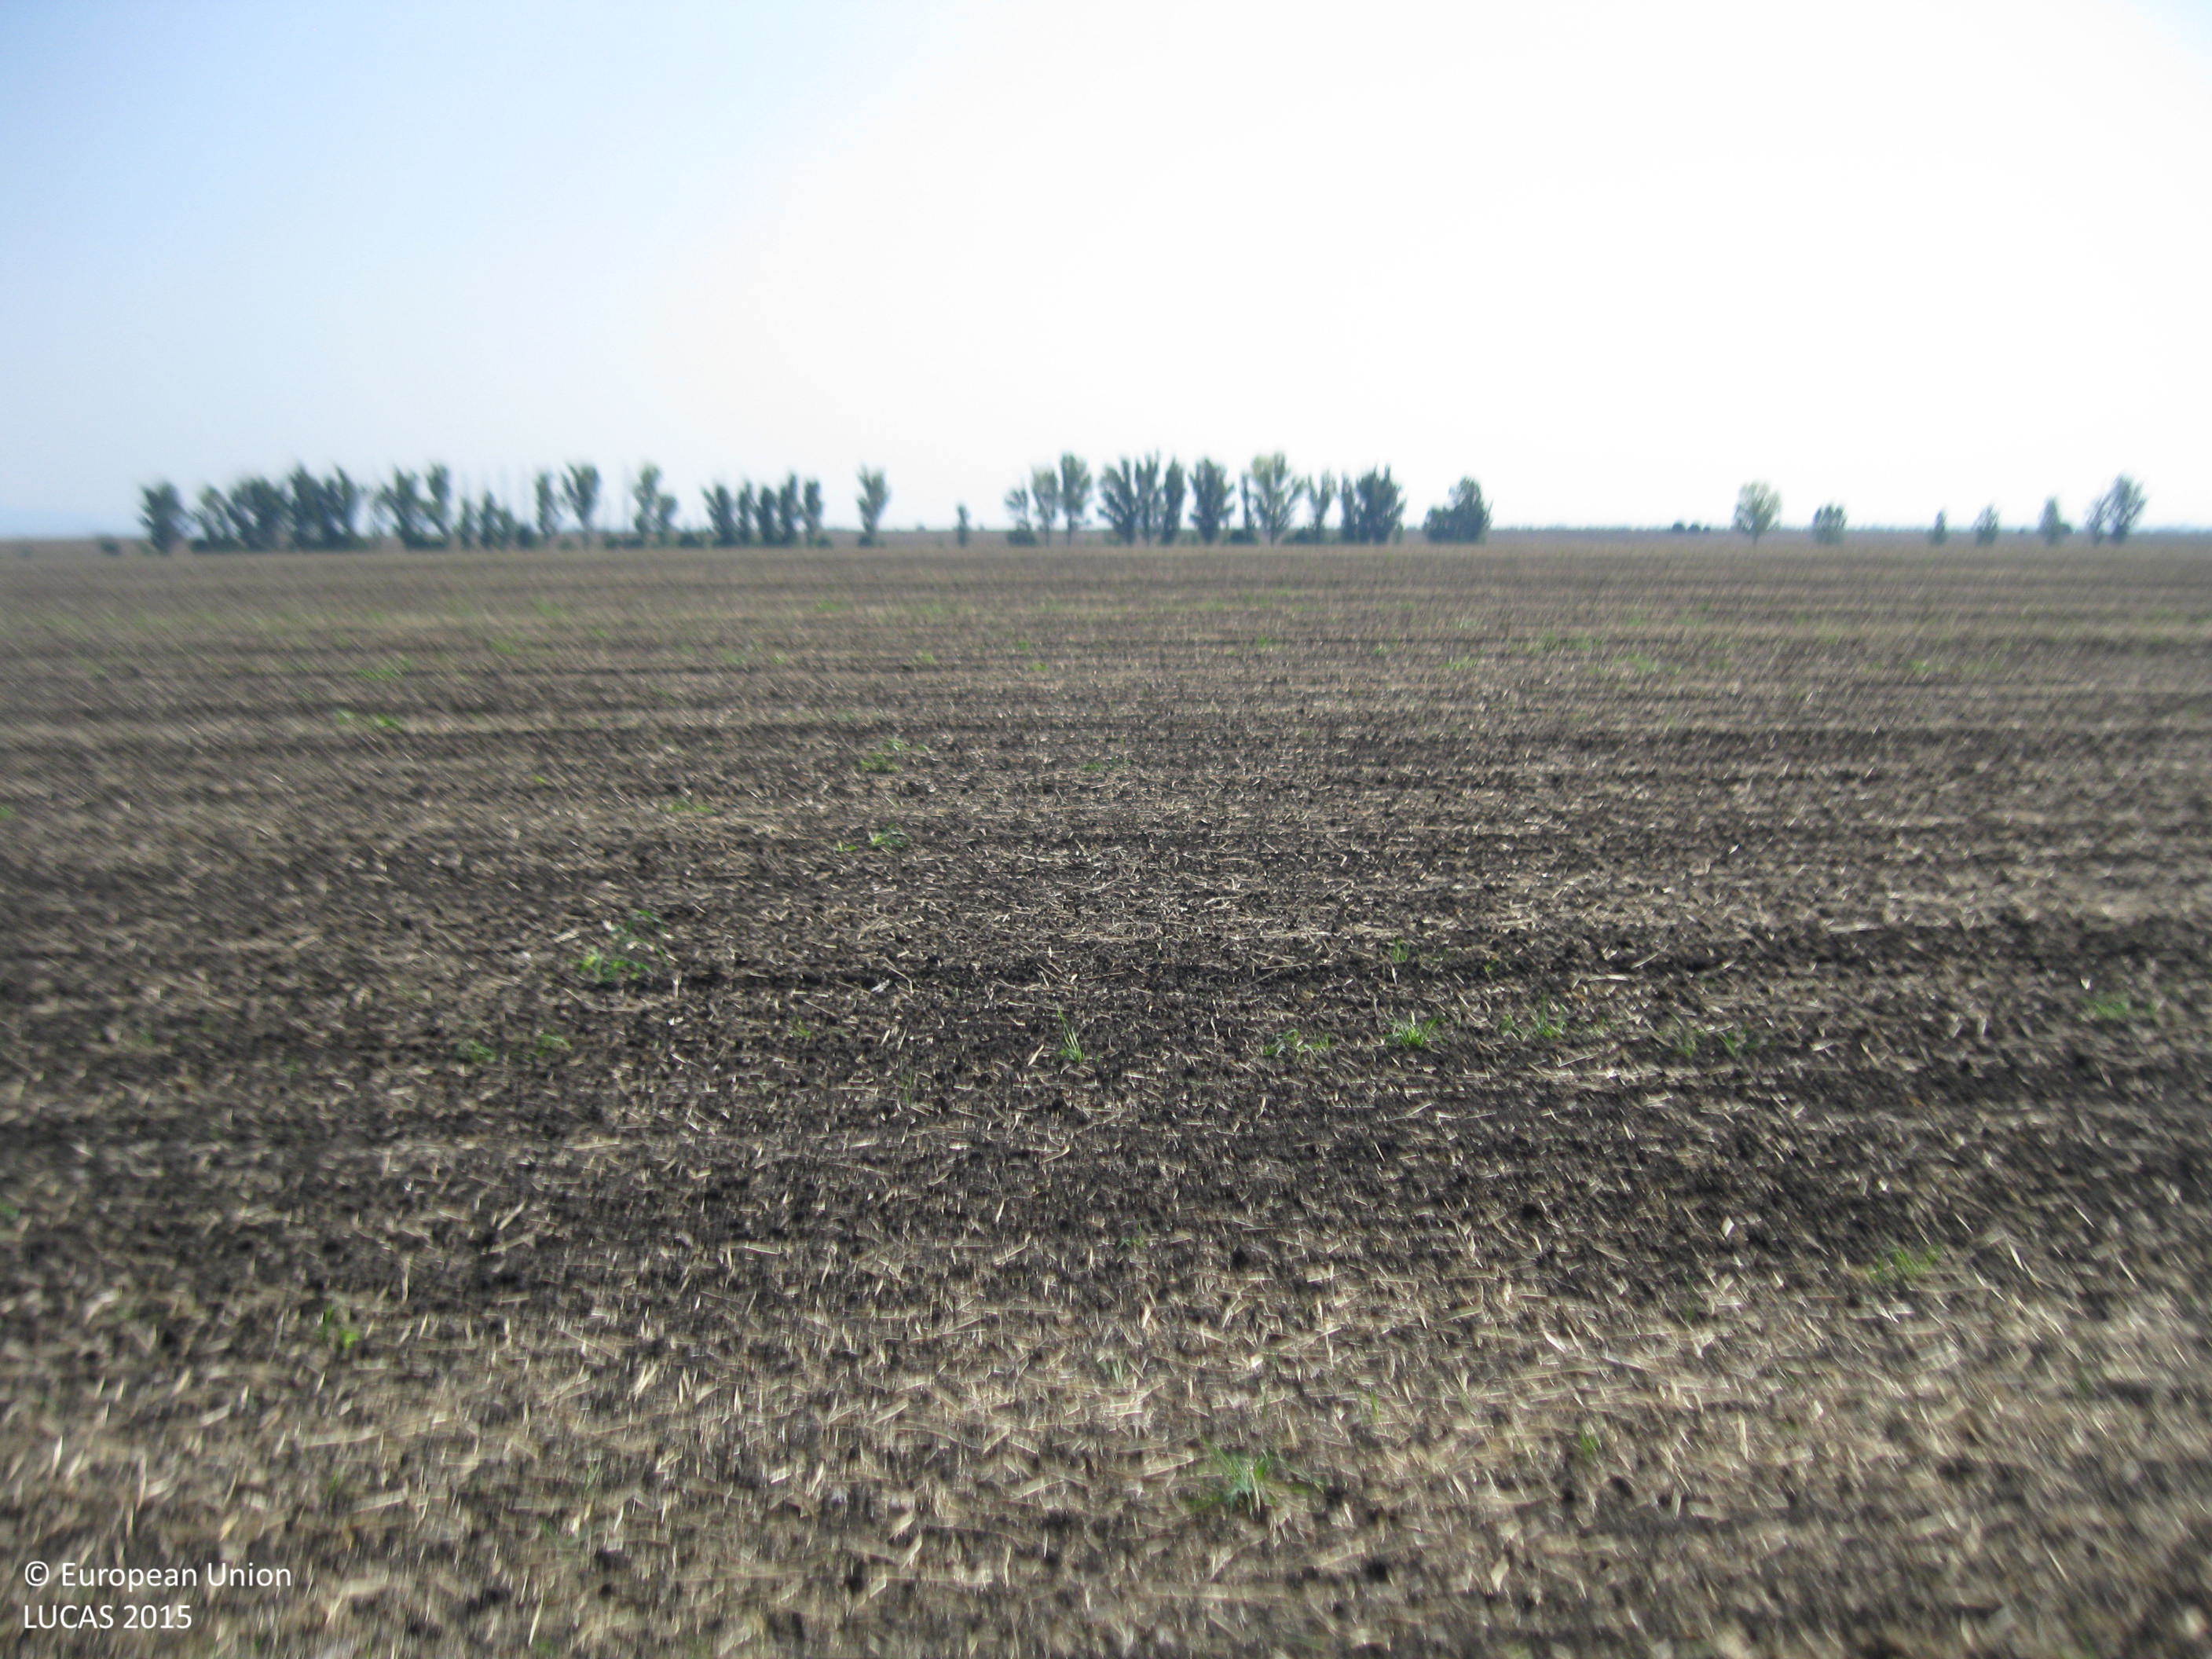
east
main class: Cropland
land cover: Common wheat
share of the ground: < 10 %
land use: Agriculture (excluding fallow land and kitchen gardens)
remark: Harvested field
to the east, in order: Common wheat
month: September
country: BG
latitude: 42.2765
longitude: 25.0331
